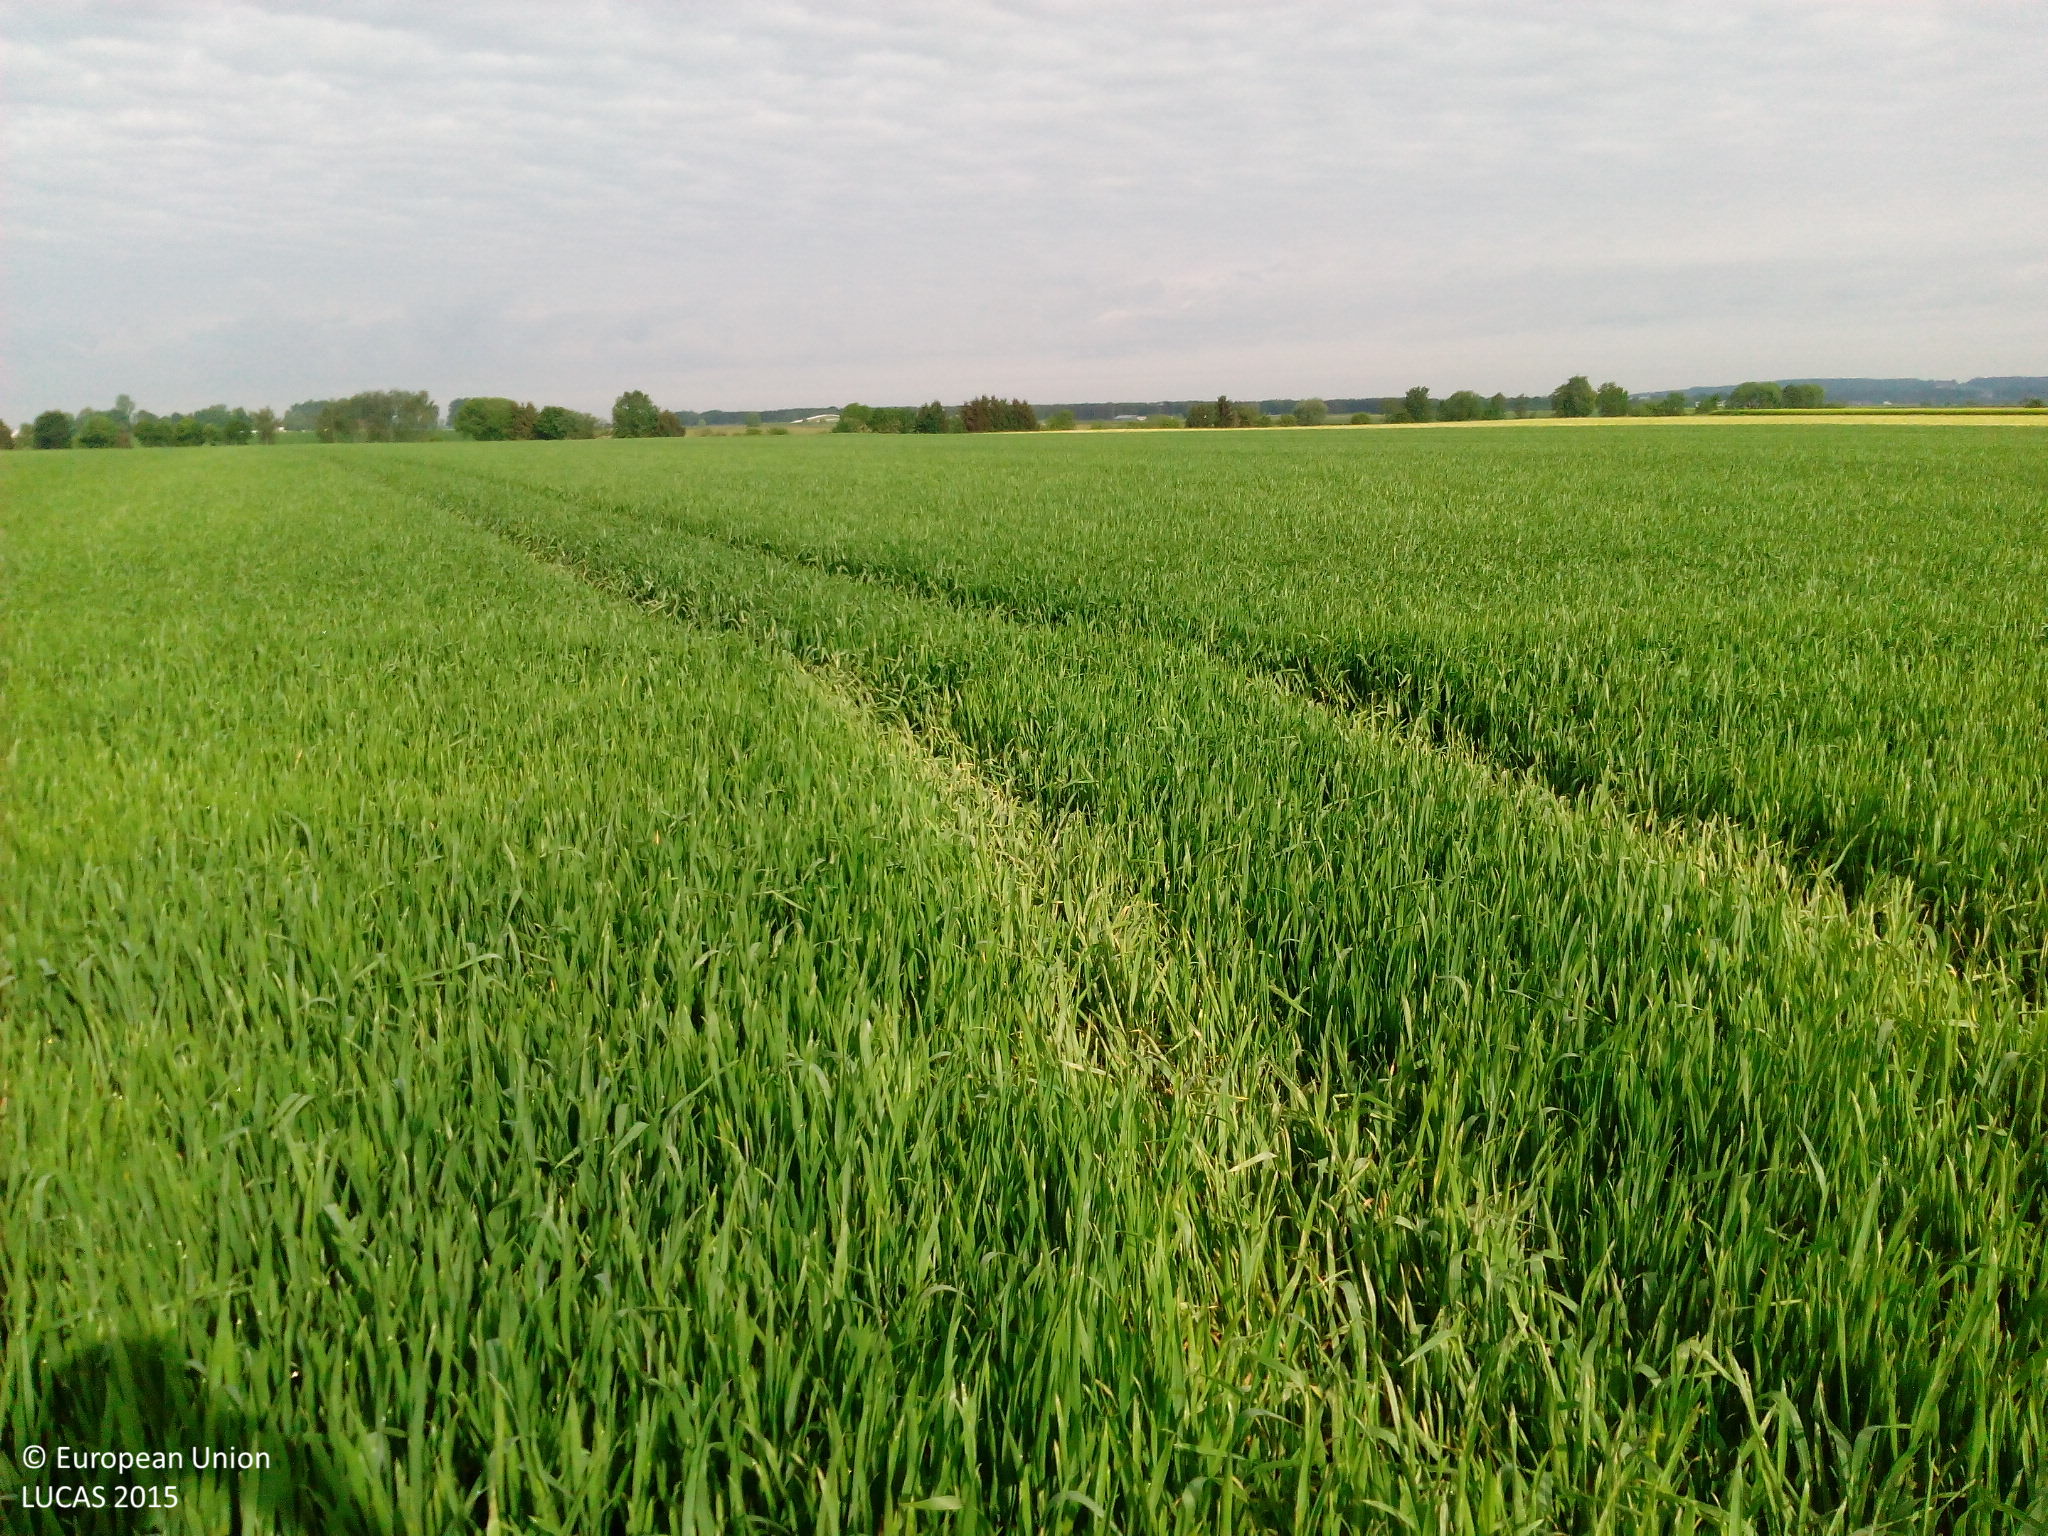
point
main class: Cropland
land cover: Common wheat
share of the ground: > 75 %
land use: Agriculture (excluding fallow land and kitchen gardens)
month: May
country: DE
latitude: 47.9713
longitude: 10.2543
